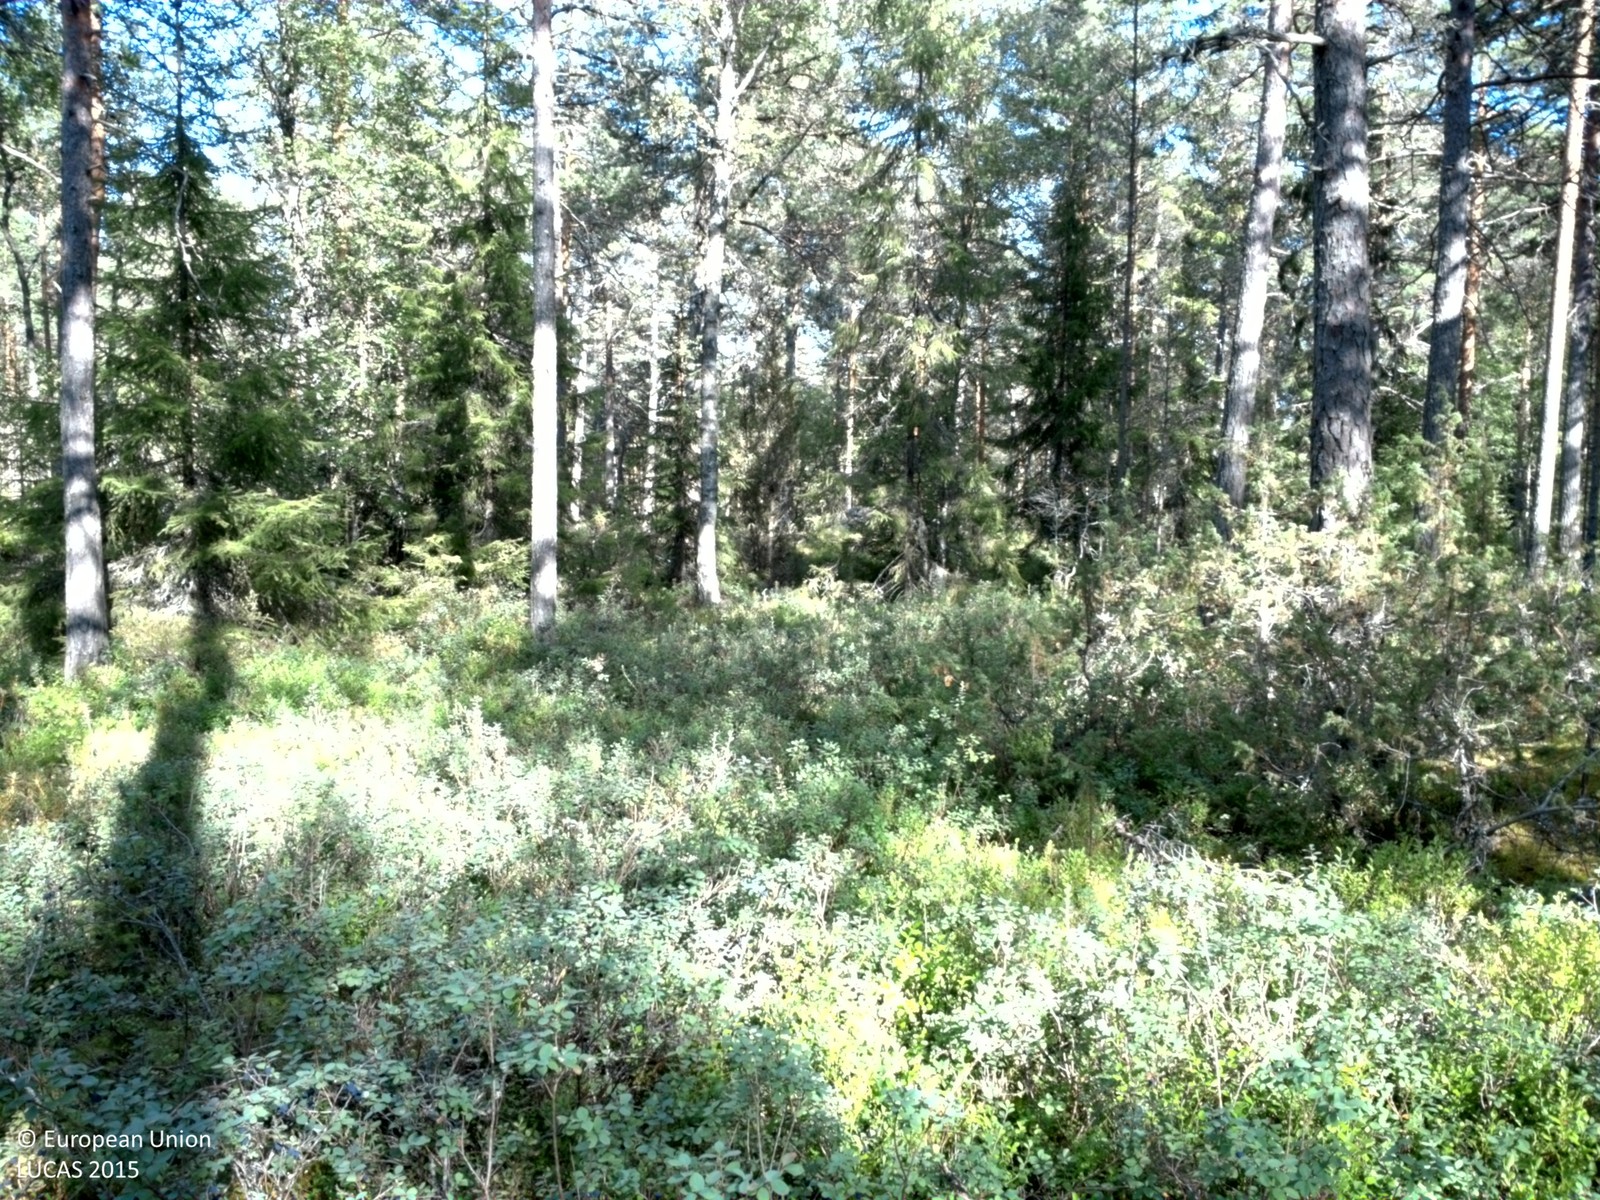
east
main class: Woodland
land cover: Pine dominated coniferous woodland
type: boreal forest
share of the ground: 50 - 75 %
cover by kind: coniferous forest trees 60 %, shrubs 20 %, lichens and mosses 20 %
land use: Forestry
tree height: > 5 m
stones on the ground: 10 - 25 %
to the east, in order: Pine dominated coniferous woodland; Tracks; Pine dominated coniferous woodland; Electric lines; Broadleaved woodland; Electric lines; Broadleaved woodland; Pine dominated coniferous woodland; Grass margins; Paved roads, cycling and walking lanes; Grass margins; Pine dominated coniferous woodland
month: August
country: SE
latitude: 59.9573
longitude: 16.5269
